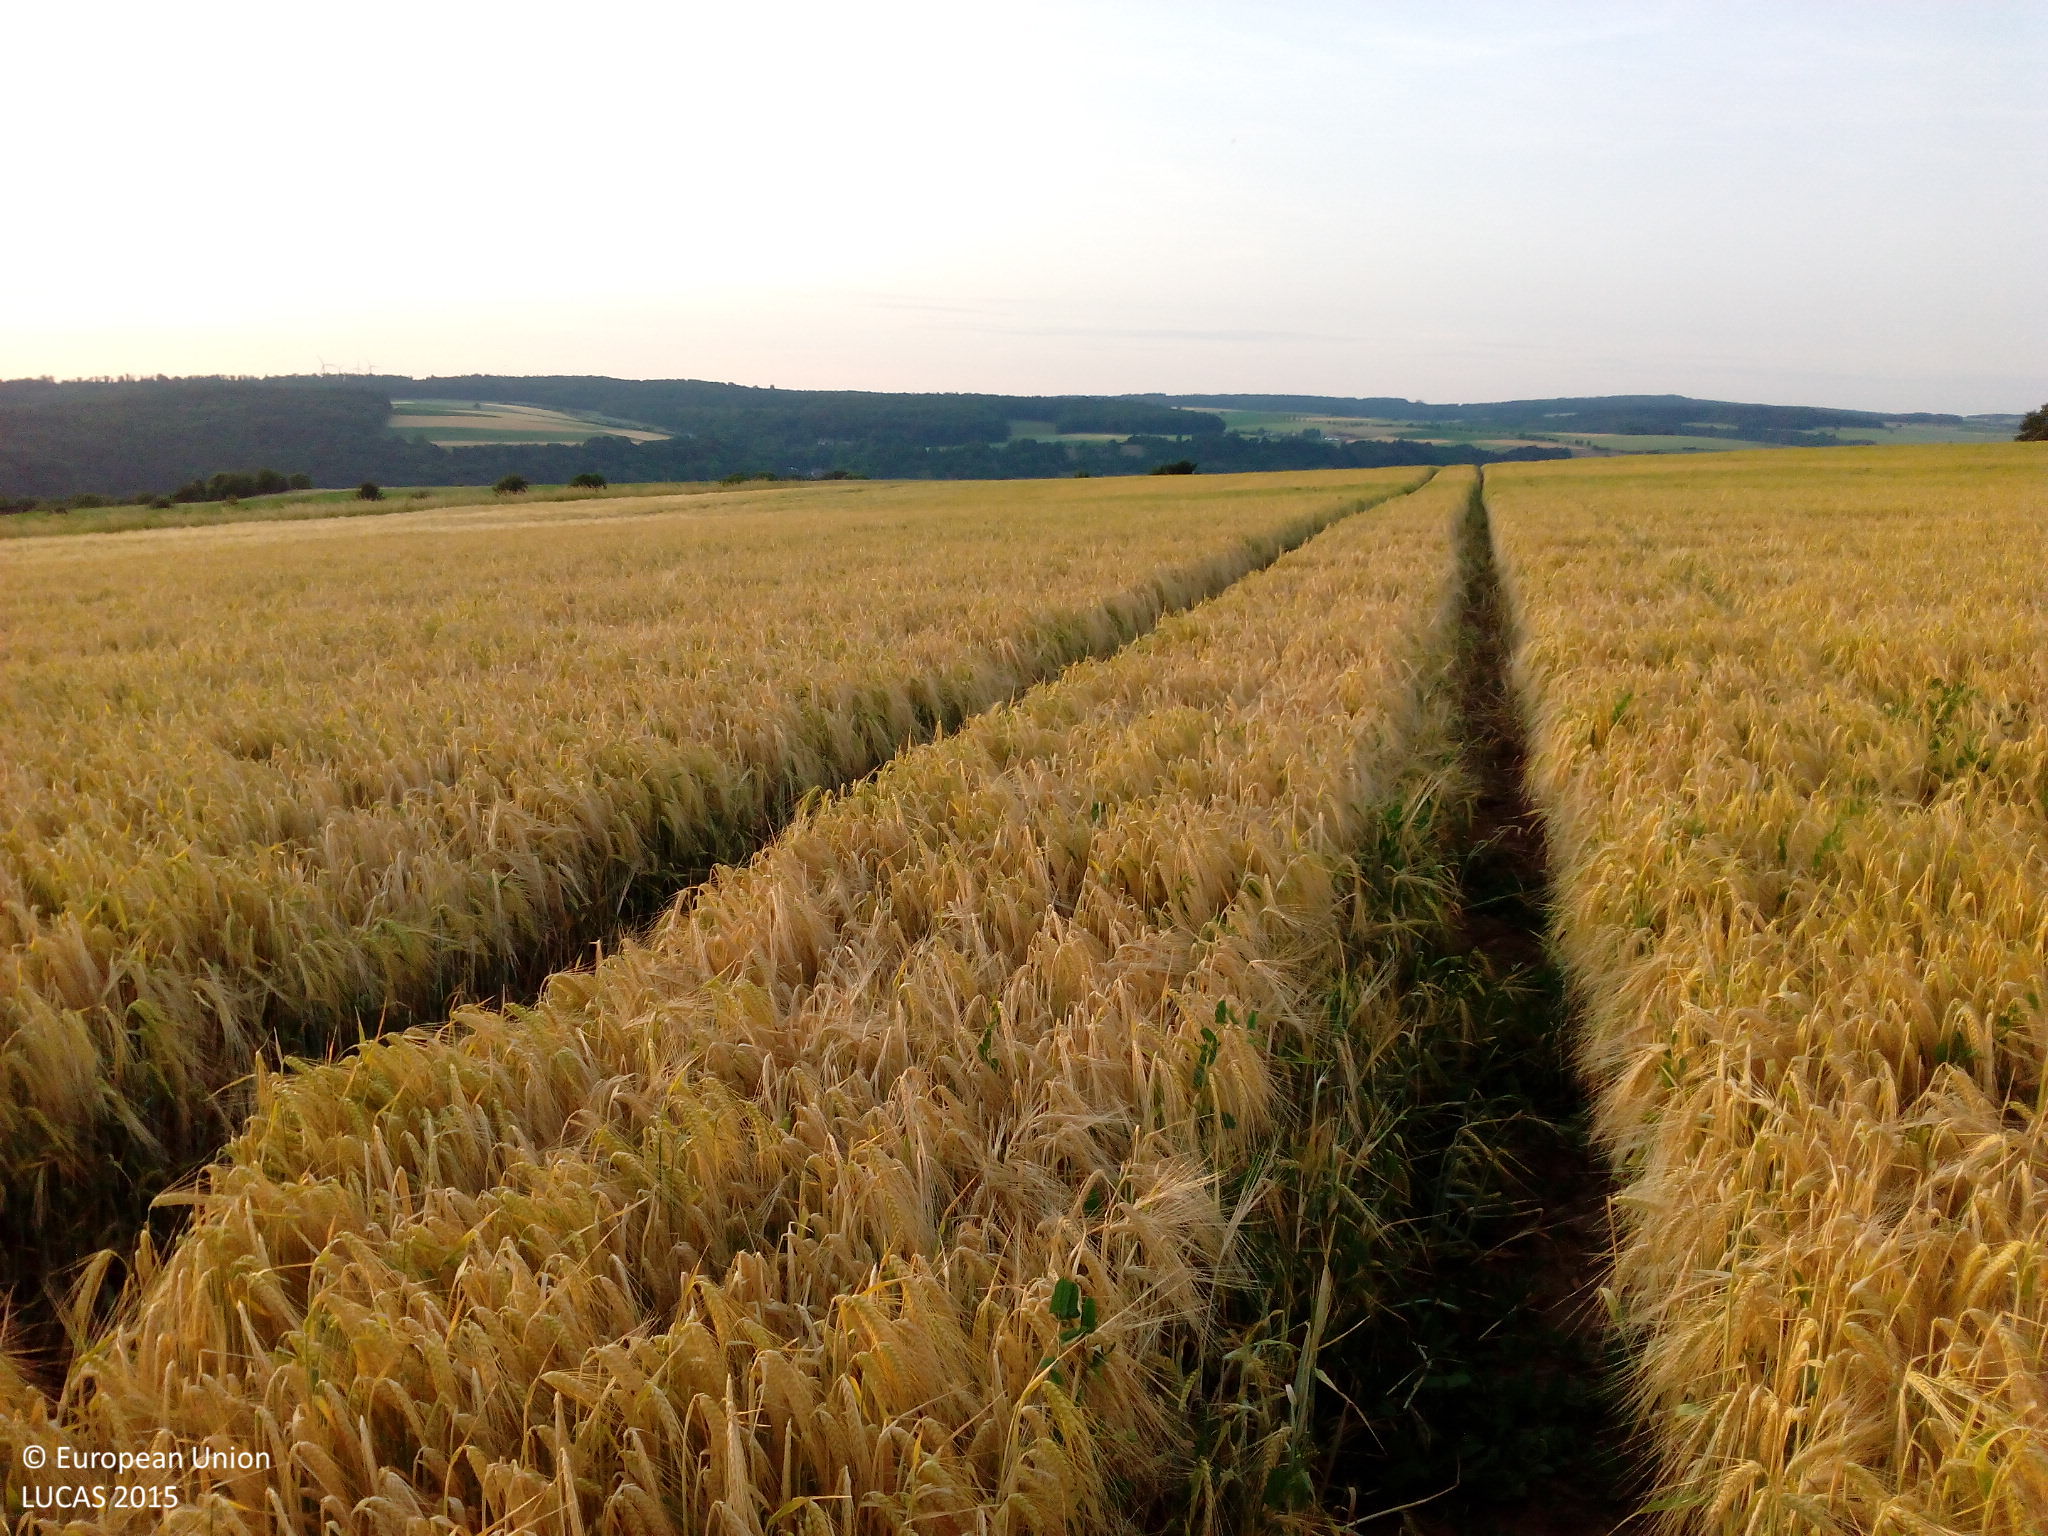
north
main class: Cropland
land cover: Barley
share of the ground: > 75 %
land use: Agriculture (excluding fallow land and kitchen gardens)
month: June
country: DE
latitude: 49.3381
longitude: 9.5735
